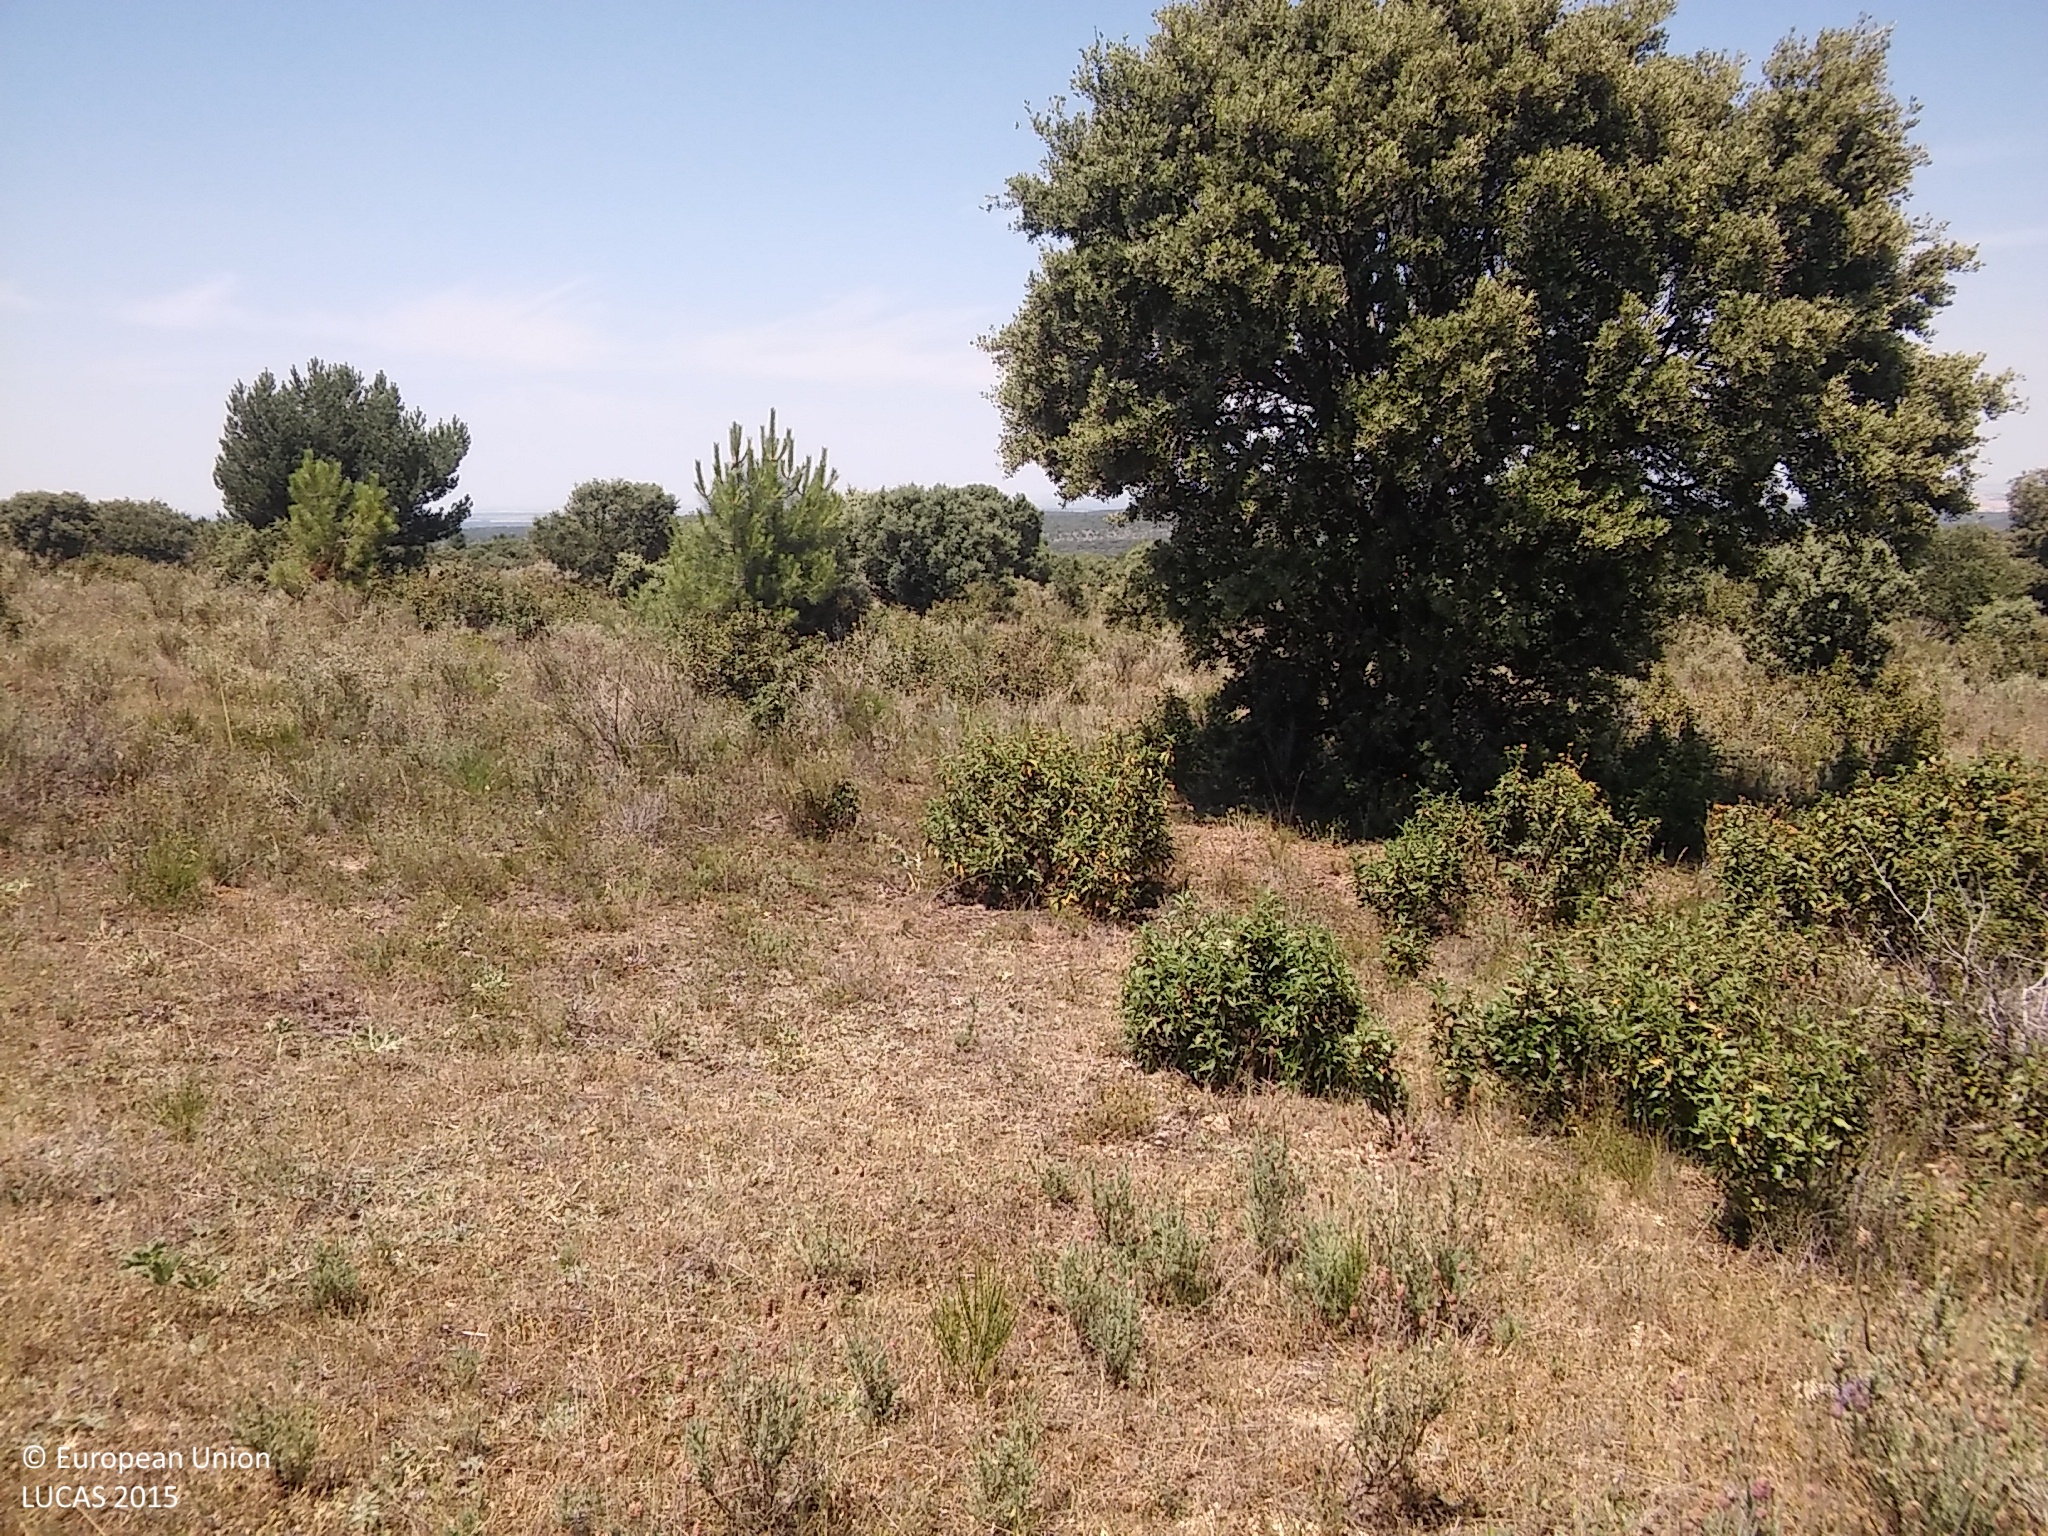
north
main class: Shrubland
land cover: Shrubland with sparse tree cover
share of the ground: 50 - 75 %
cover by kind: shrubs 55 %, herbaceous plants 40 %, coniferous forest trees 5 %
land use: Agriculture (excluding fallow land and kitchen gardens)
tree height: < 5 m
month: June
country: ES
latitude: 41.1050
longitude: -3.8973
